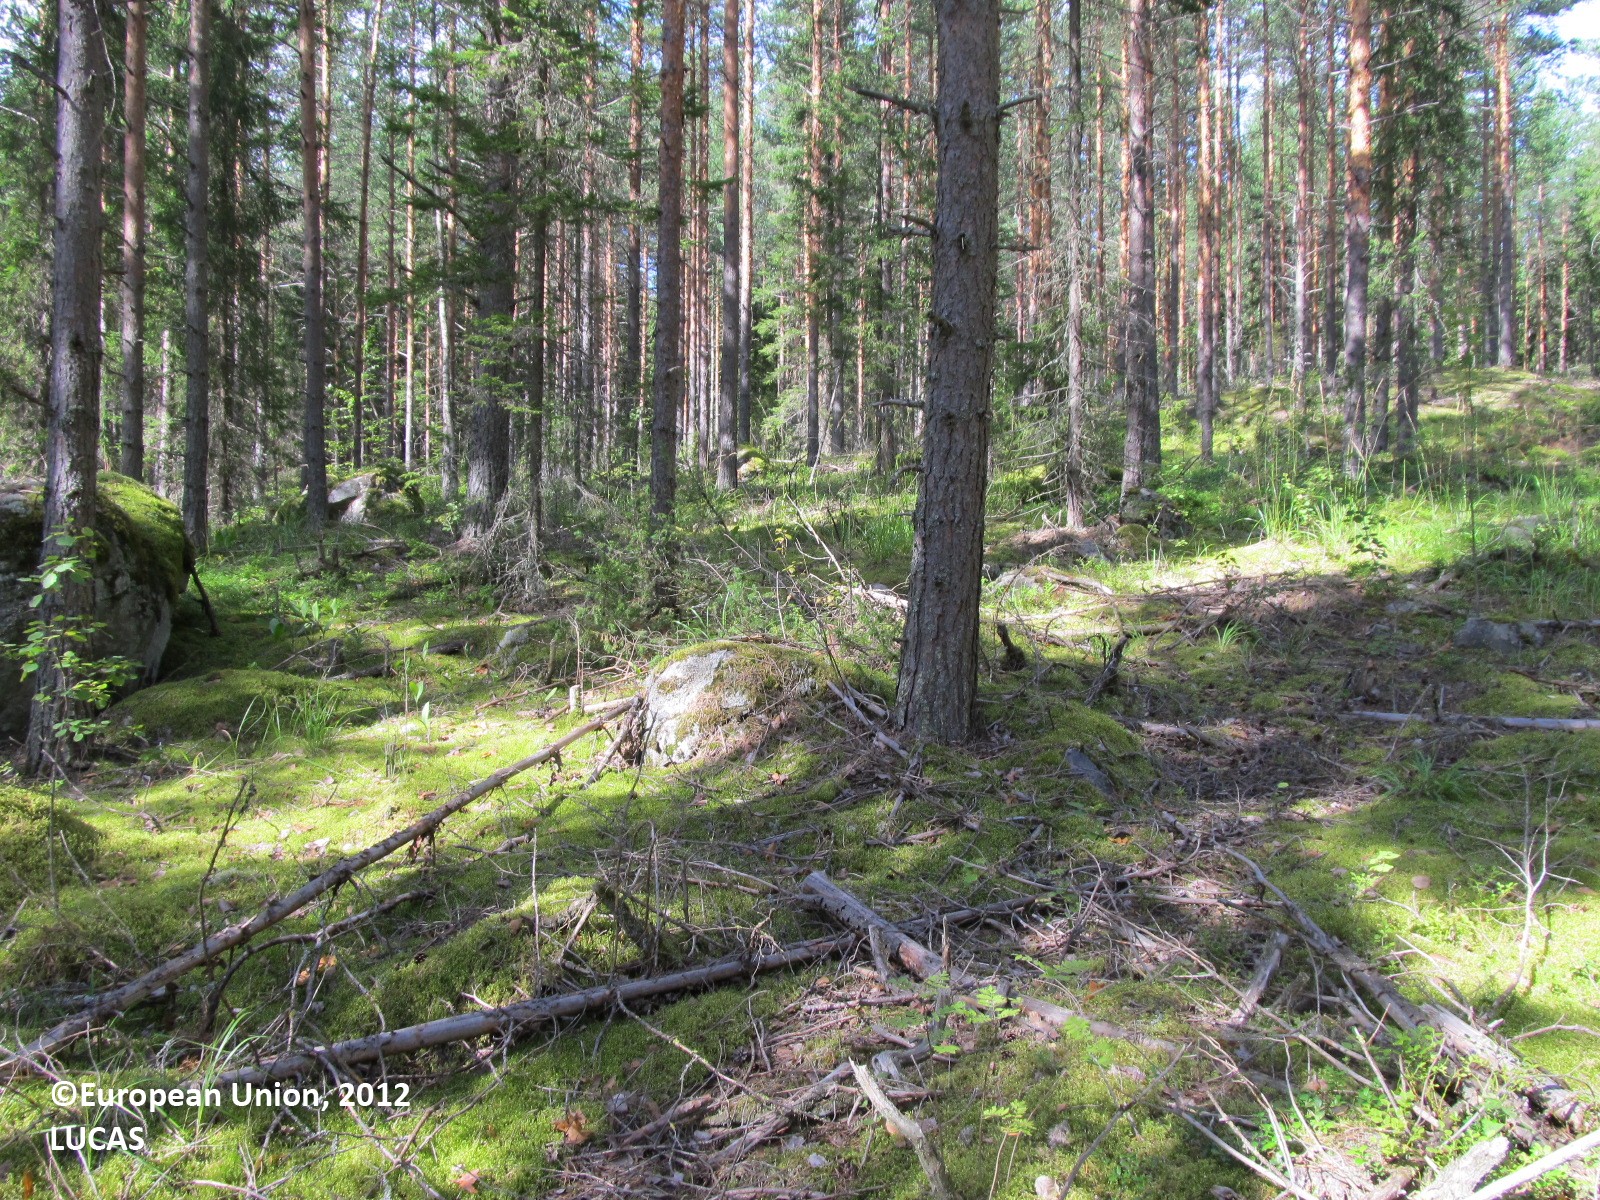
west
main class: Woodland
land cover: Other coniferous woodland
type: boreal forest
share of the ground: 25 - 50 %
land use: Forestry
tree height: > 5 m
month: August
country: FI
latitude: 61.6762
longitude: 27.4233
